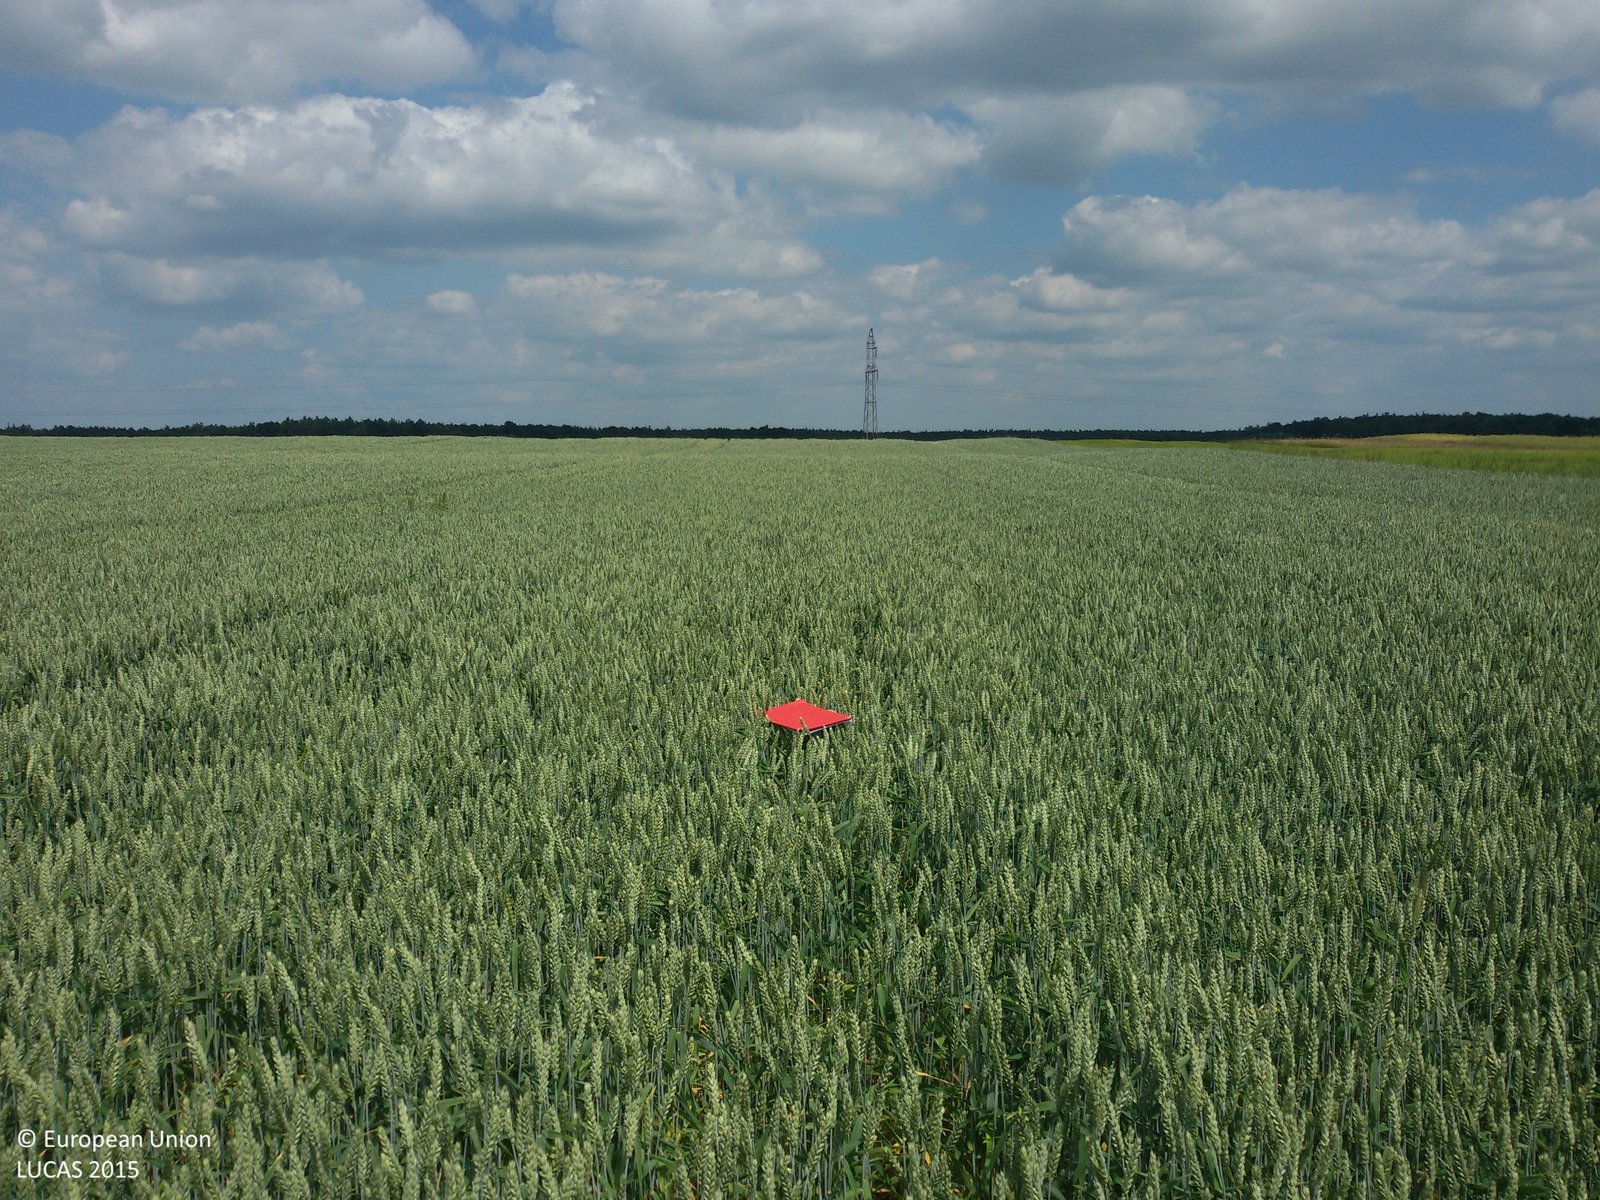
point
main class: Cropland
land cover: Common wheat
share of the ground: > 75 %
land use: Agriculture (excluding fallow land and kitchen gardens)
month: June
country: PL
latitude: 50.8677
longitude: 21.7199
